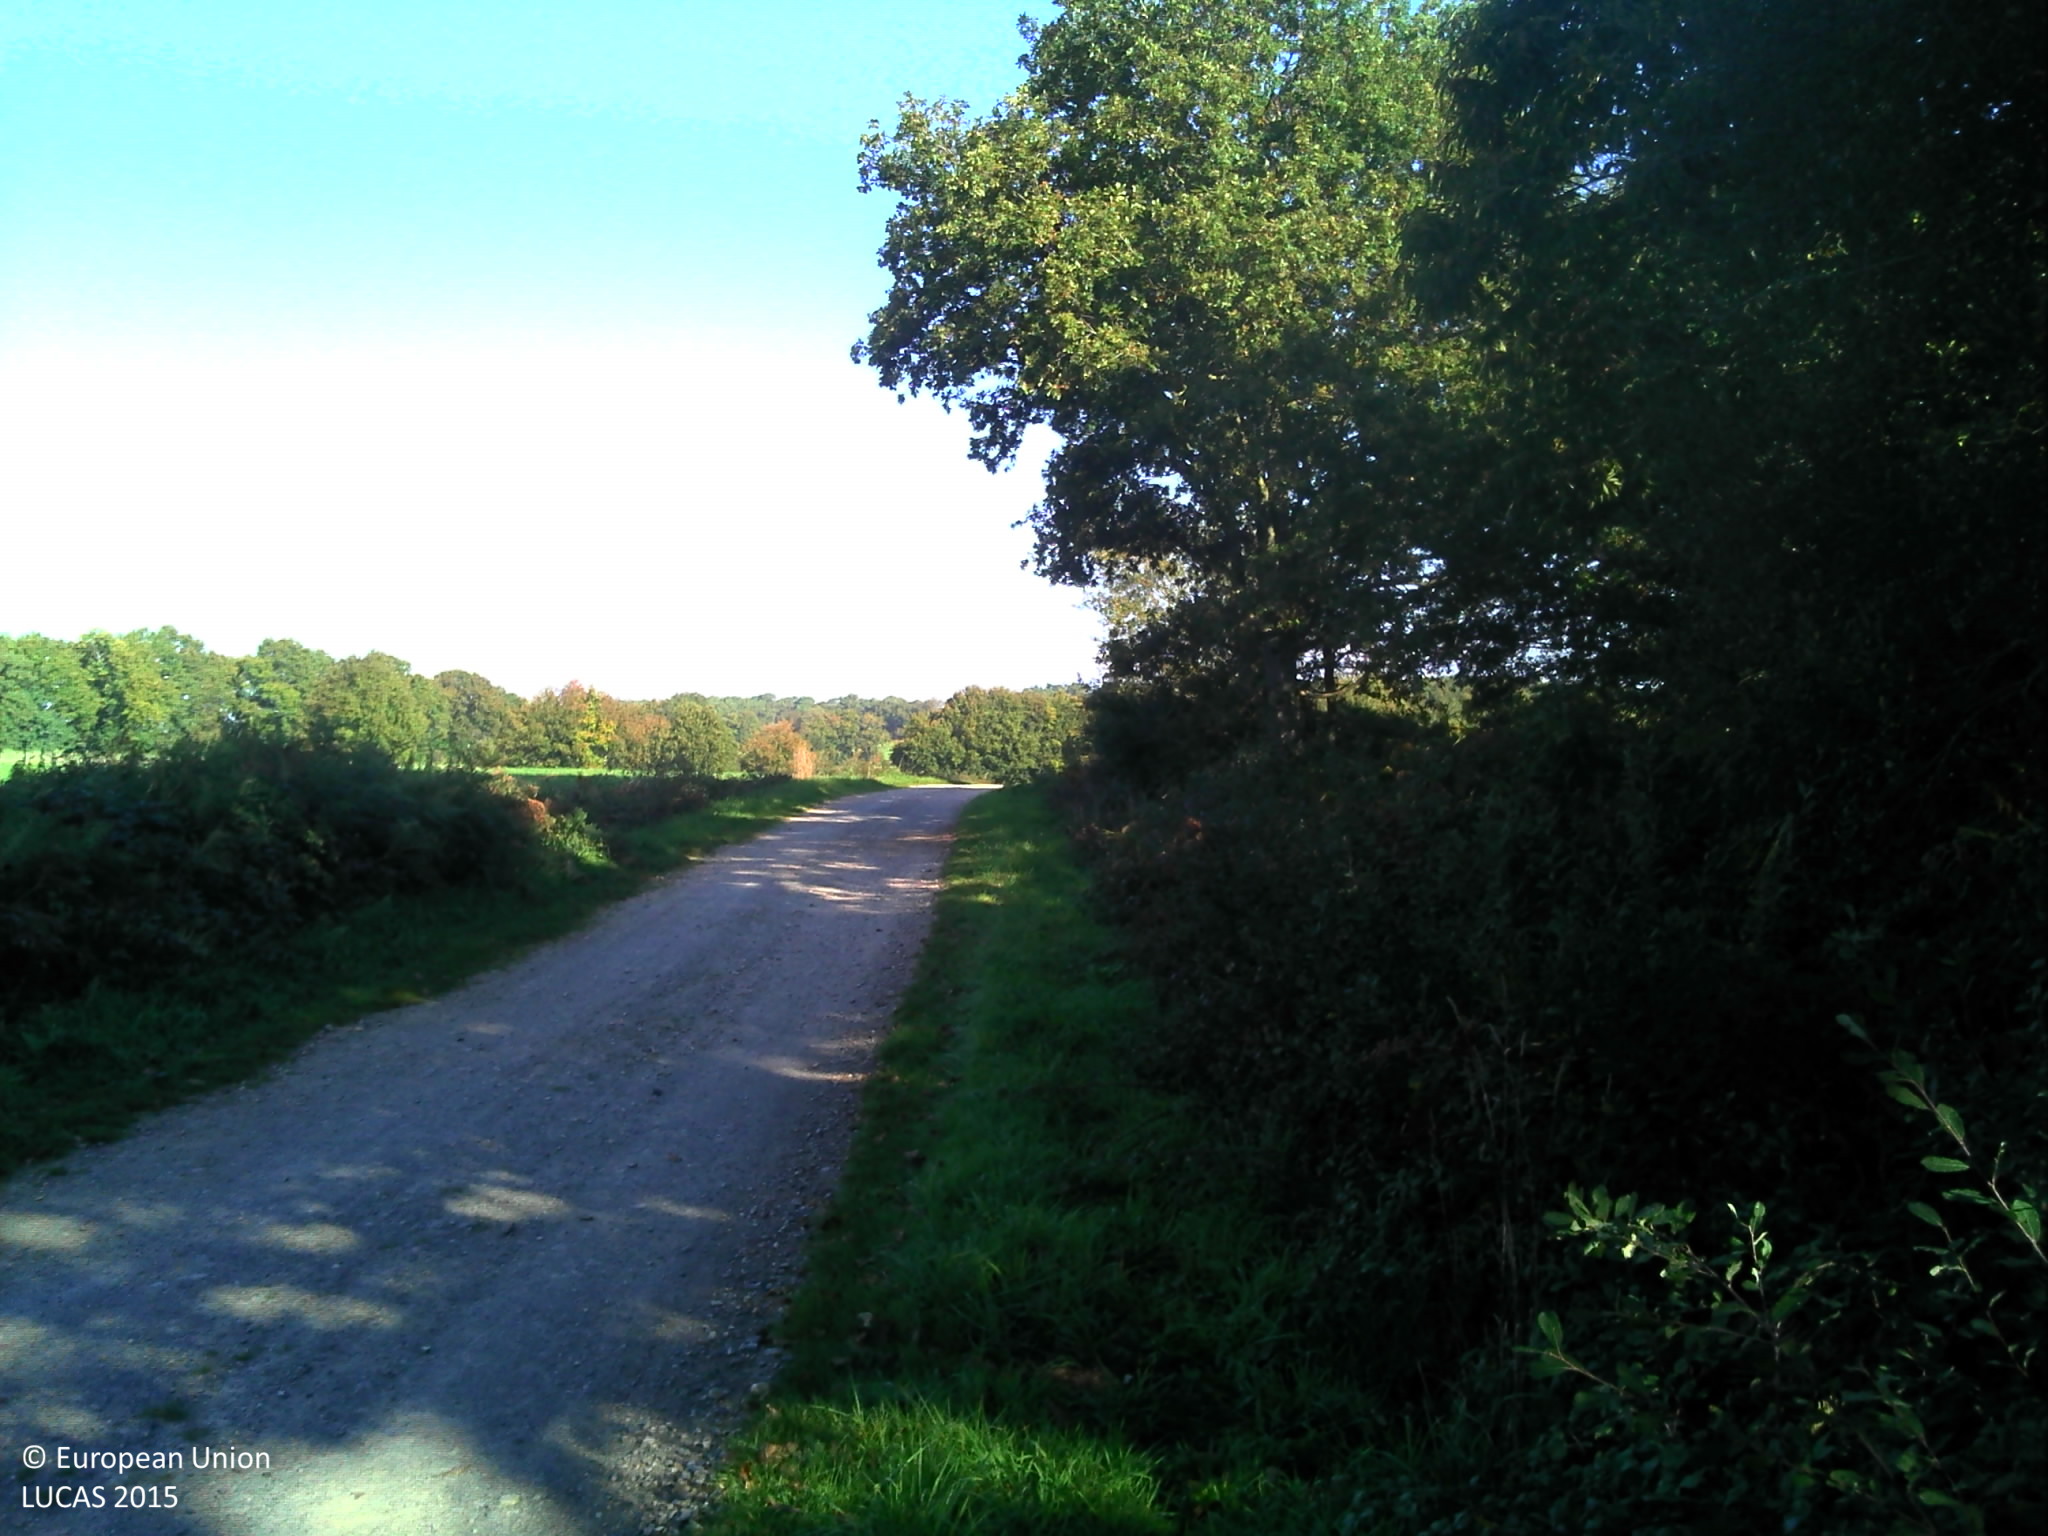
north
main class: Woodland
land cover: Broadleaved woodland
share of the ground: > 75 %
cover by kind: broadleaved forest trees 100 %
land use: Semi-natural and natural areas not in use
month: October
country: FR
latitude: 47.7428
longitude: -2.2034
